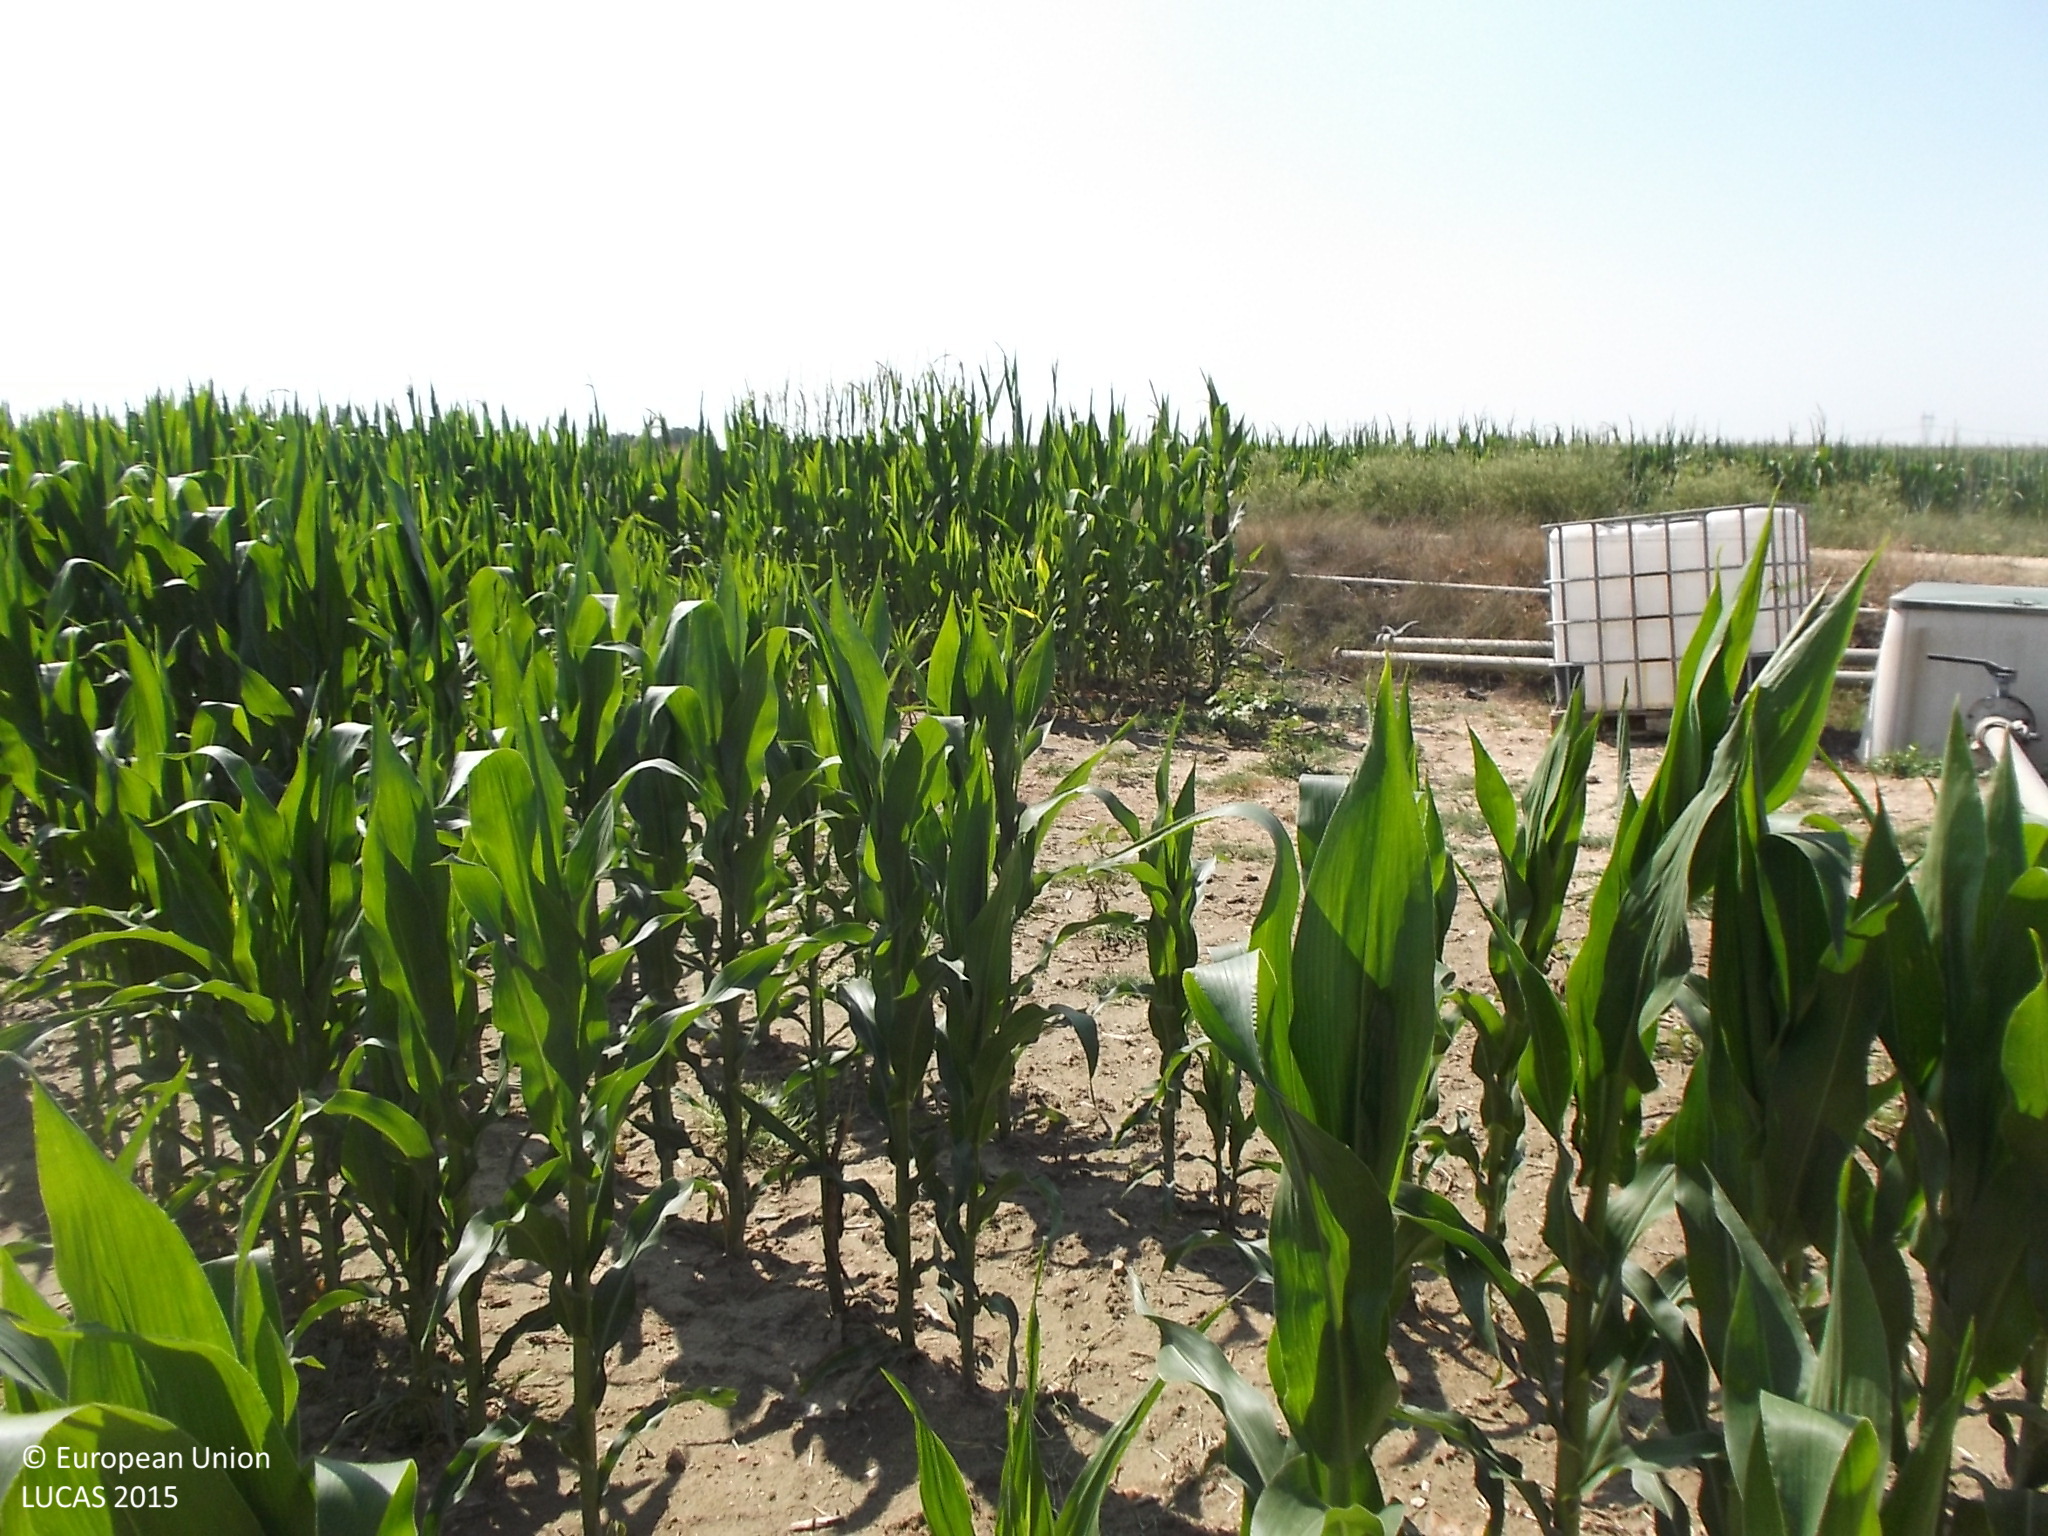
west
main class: Cropland
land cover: Maize
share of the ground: > 75 %
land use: Agriculture (excluding fallow land and kitchen gardens)
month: July
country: ES
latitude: 41.4484
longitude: -5.2906
